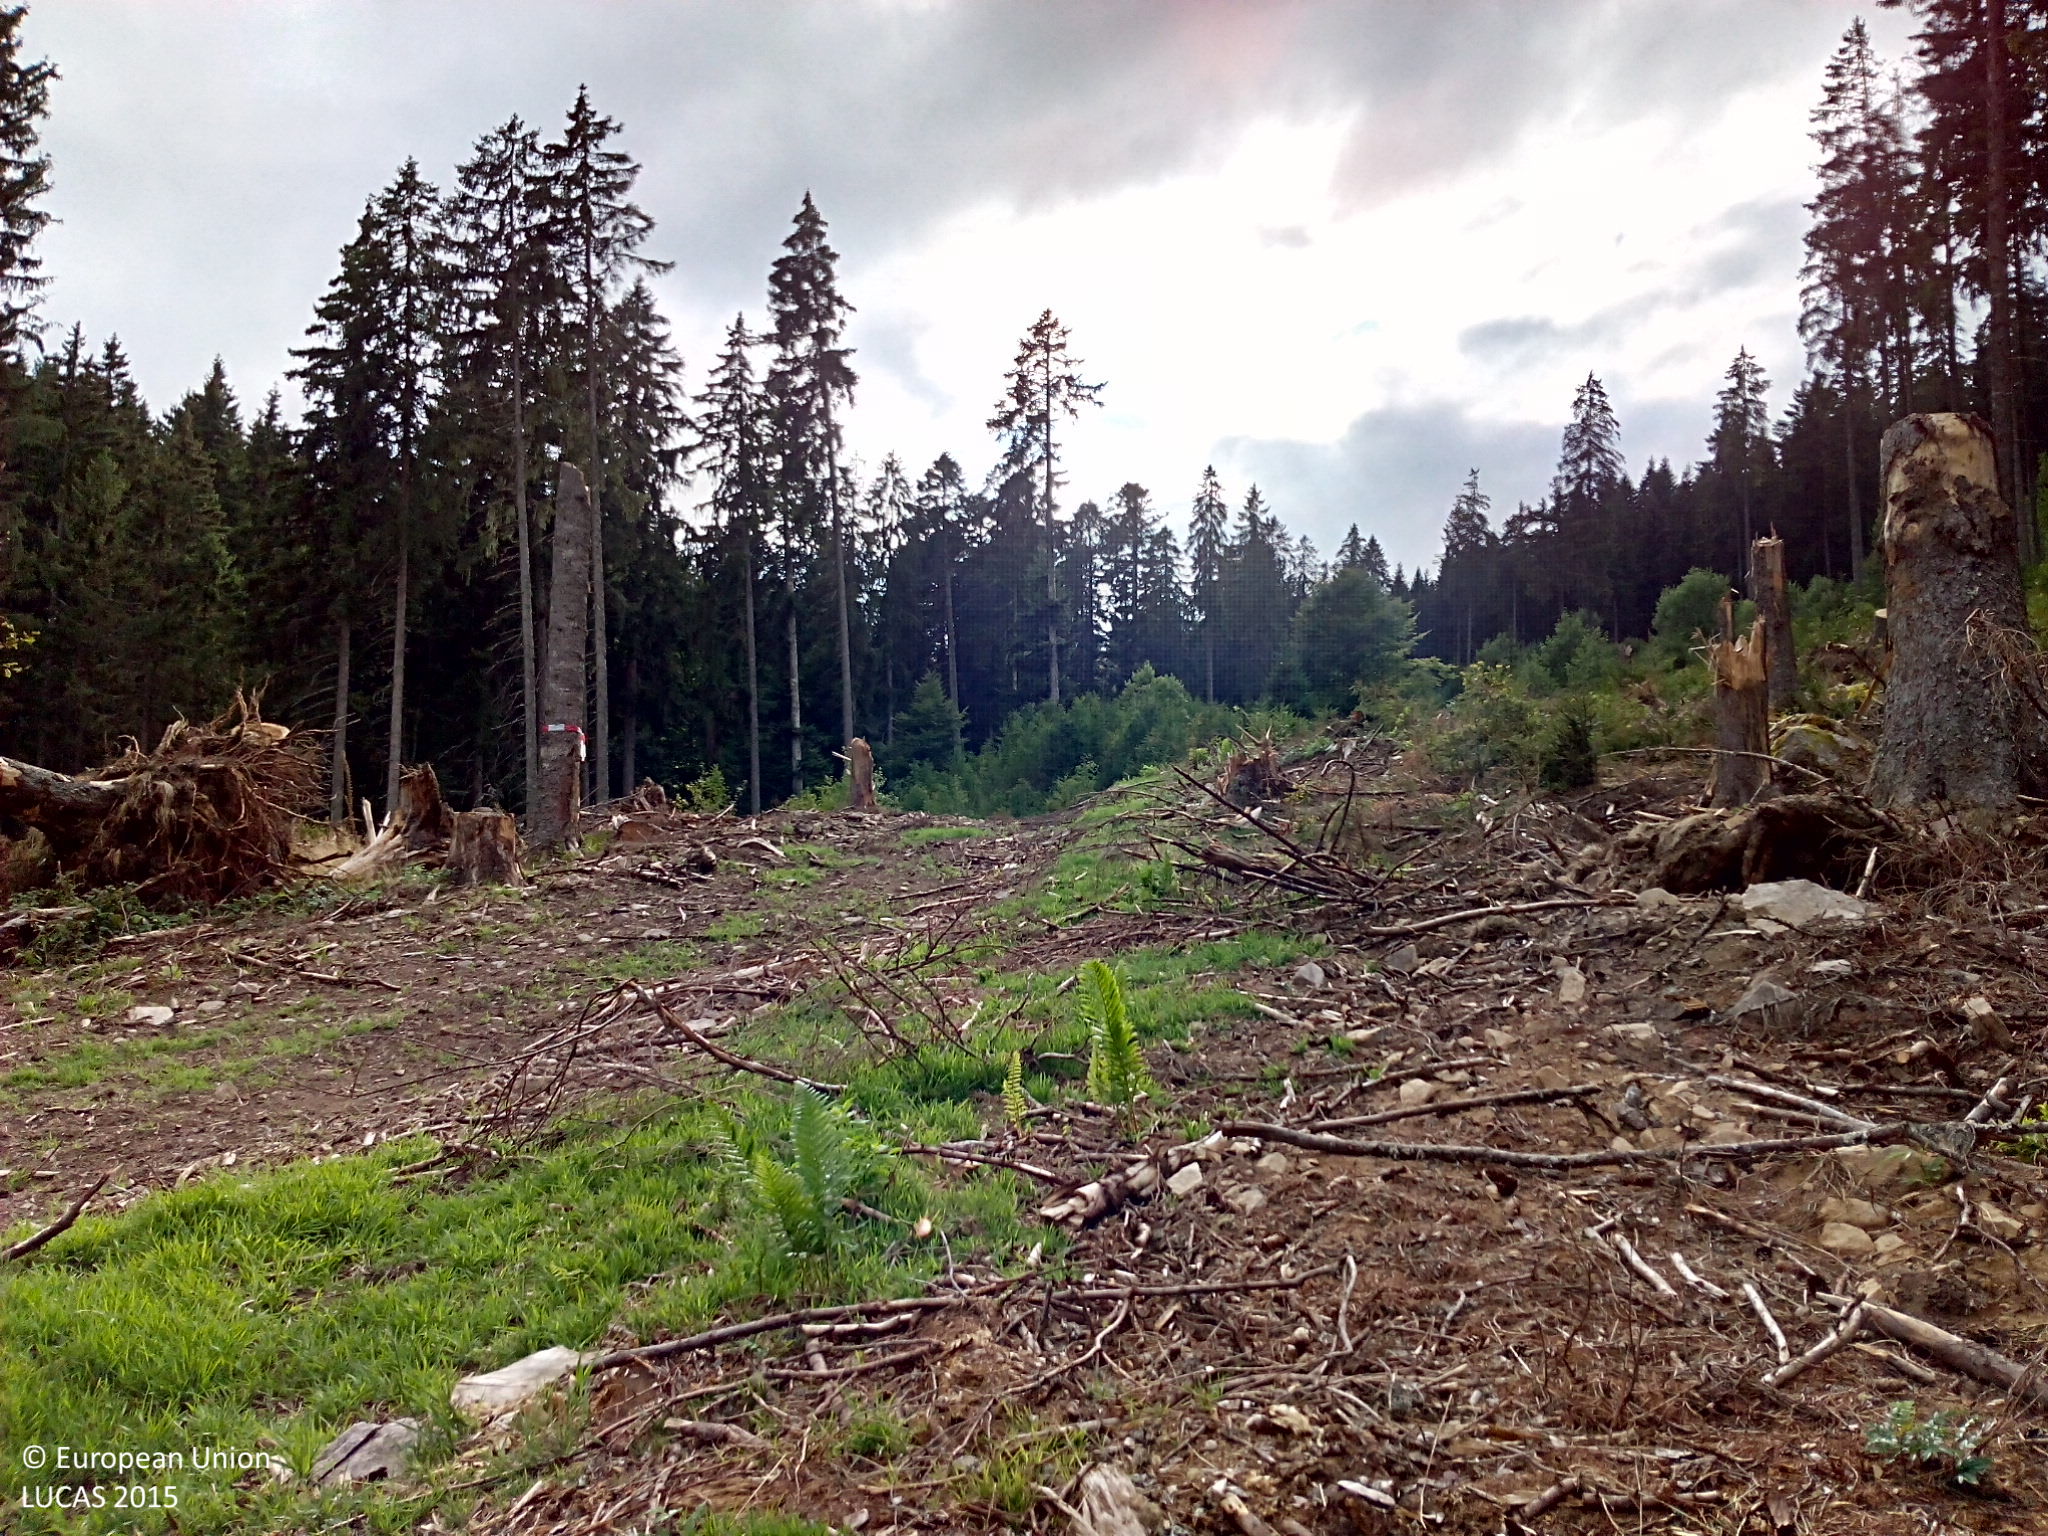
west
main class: Grassland
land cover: Spontaneously vegetated surfaces
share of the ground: 10 - 25 %
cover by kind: unconsolidated bare surface 75 %, herbaceous plants 15 %, shrubs 5 %
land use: Forestry
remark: Clear cut
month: August
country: DE
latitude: 47.8488
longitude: 8.1971
